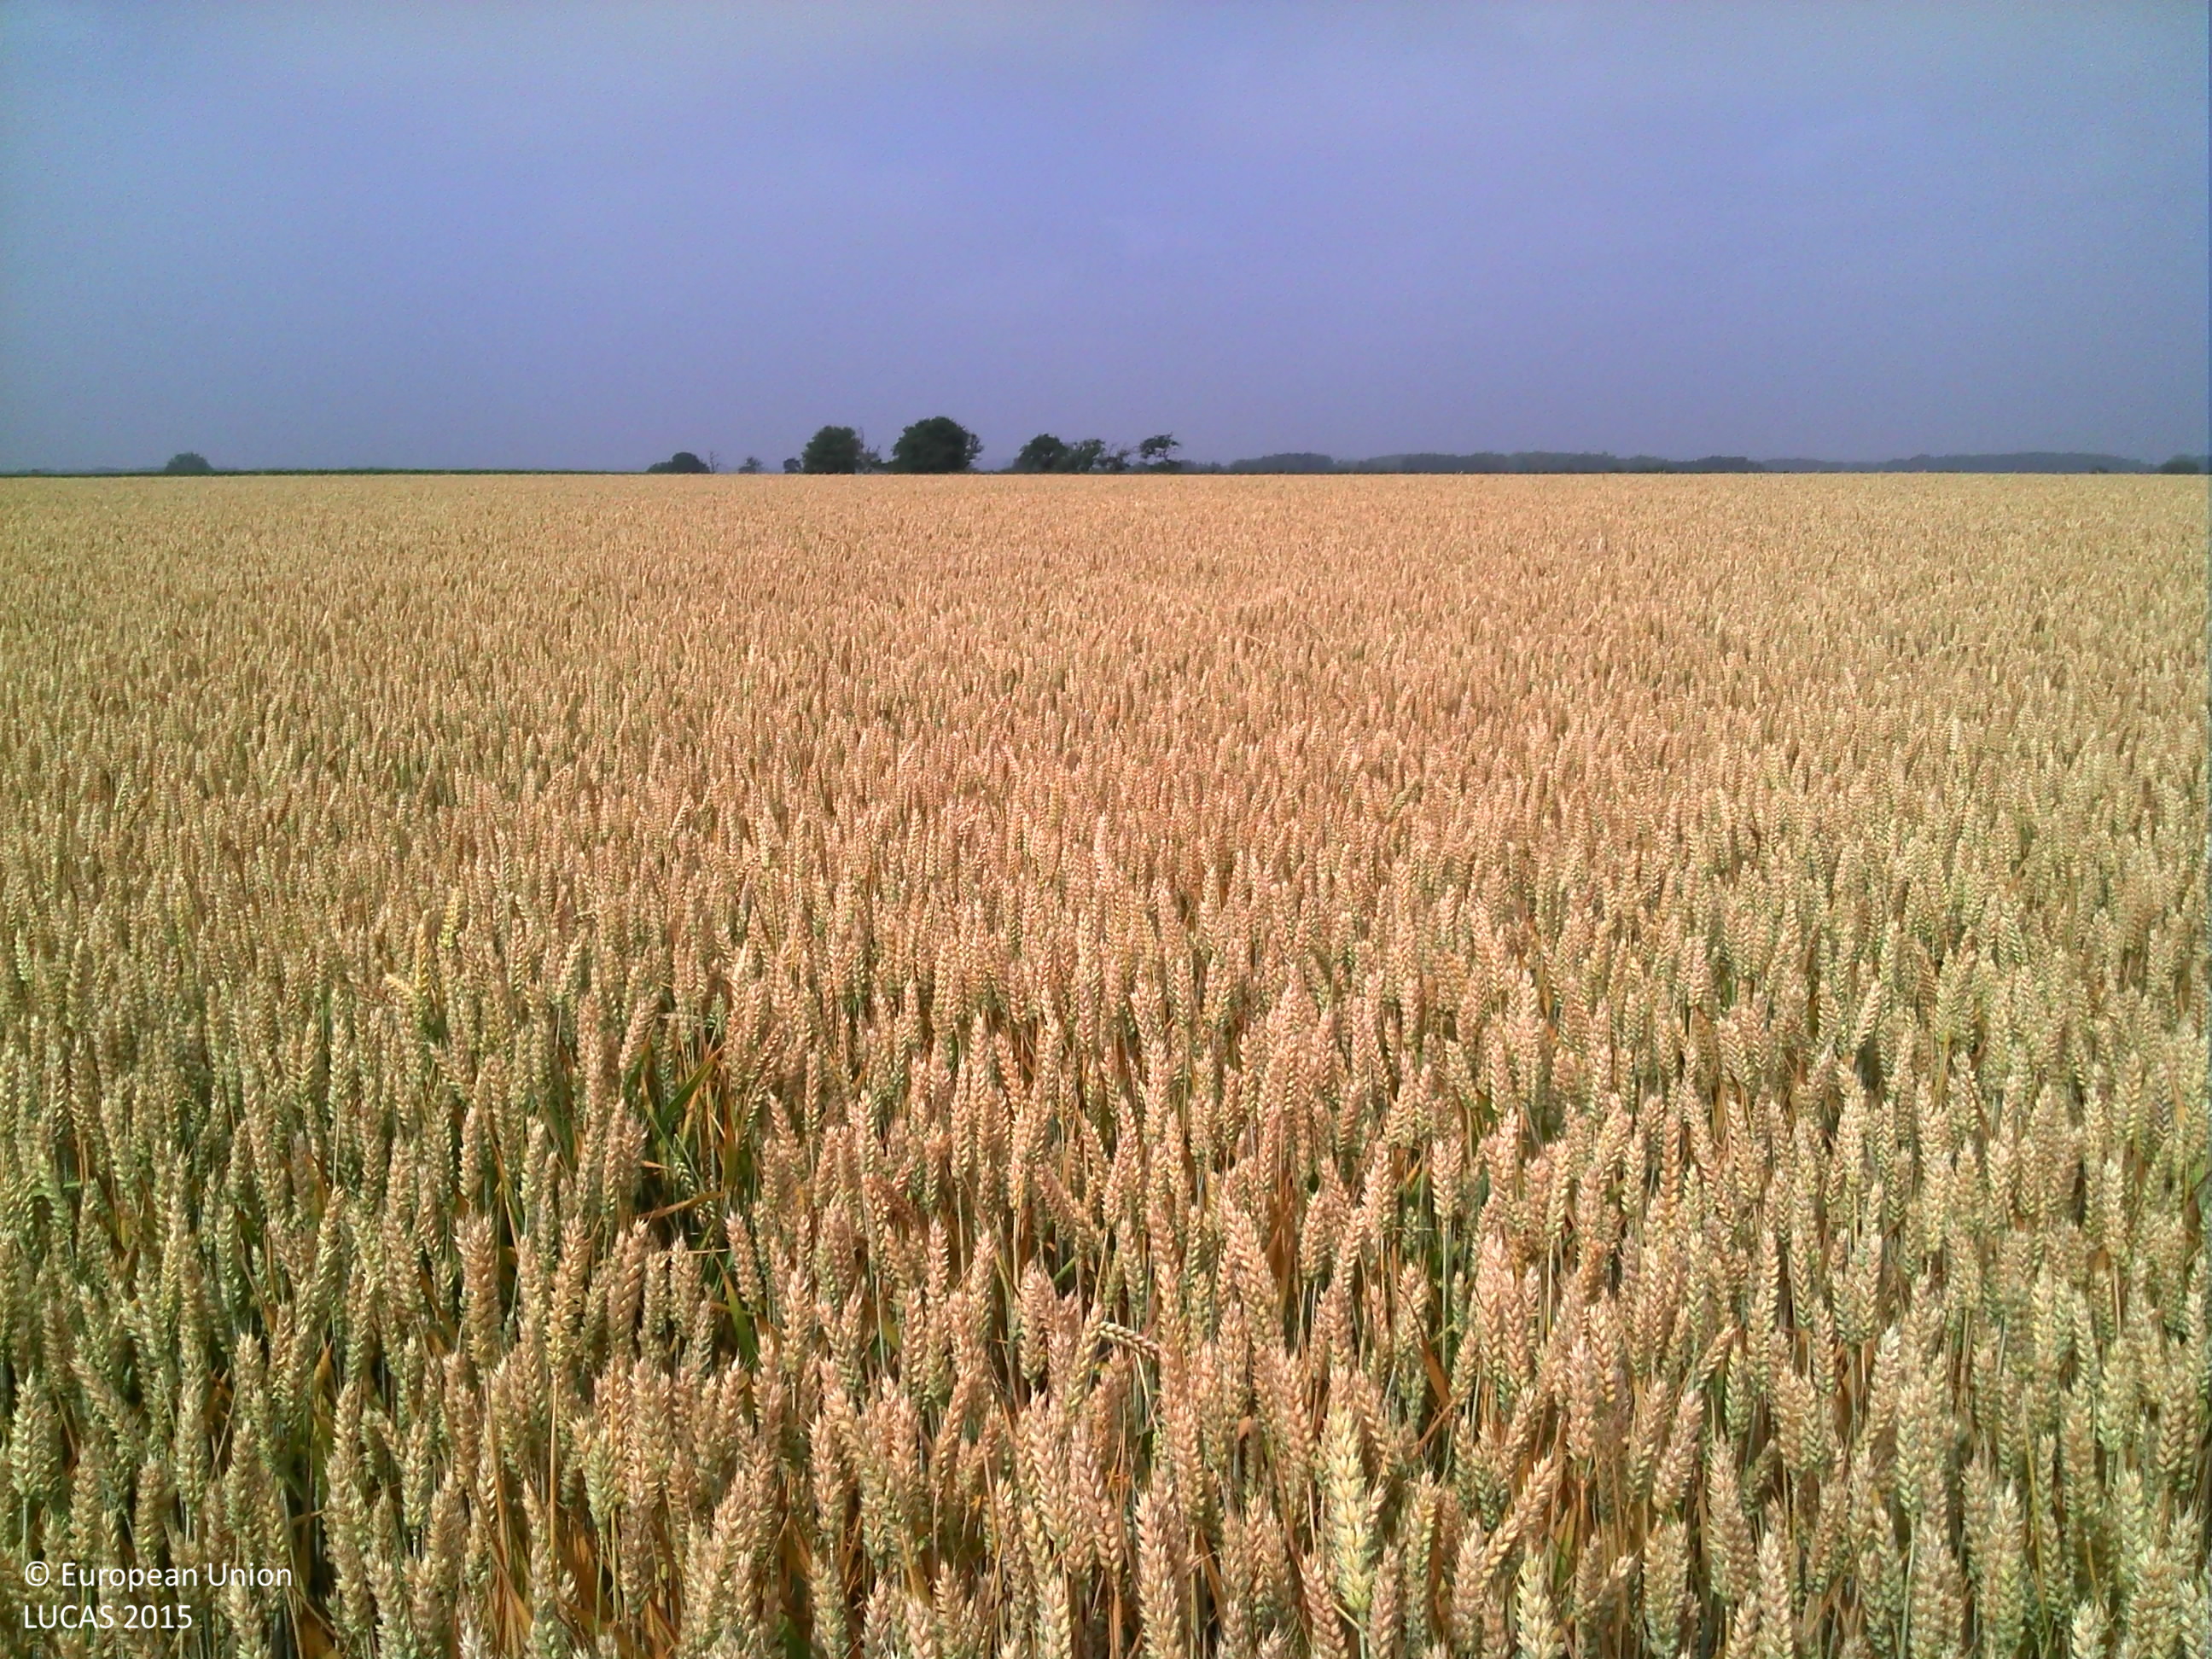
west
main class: Cropland
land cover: Common wheat
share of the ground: > 75 %
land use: Agriculture (excluding fallow land and kitchen gardens)
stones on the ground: < 10 %
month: July
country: BE
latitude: 50.8180
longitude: 5.5555
